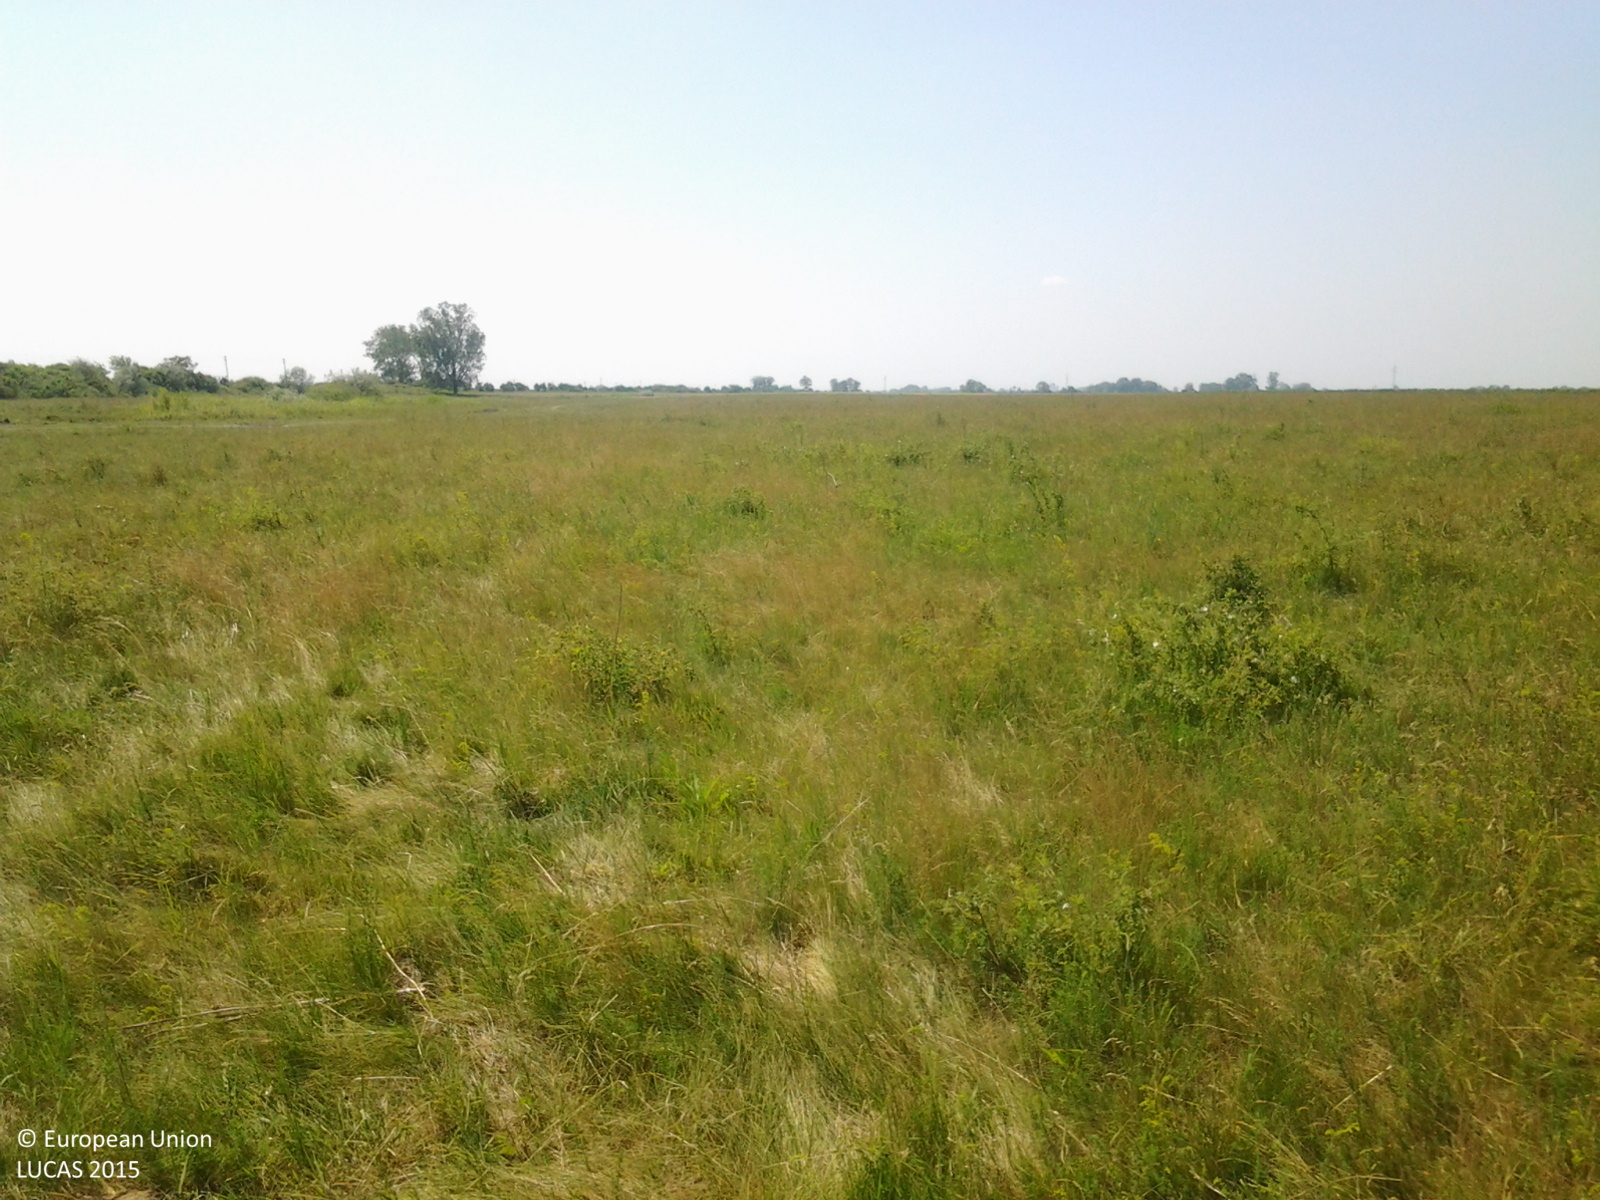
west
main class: Grassland
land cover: Grassland without tree/shrub cover
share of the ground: > 75 %
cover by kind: herbaceous plants 100 %
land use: Agriculture (excluding fallow land and kitchen gardens)
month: June
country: HU
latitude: 46.5243
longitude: 19.1006
